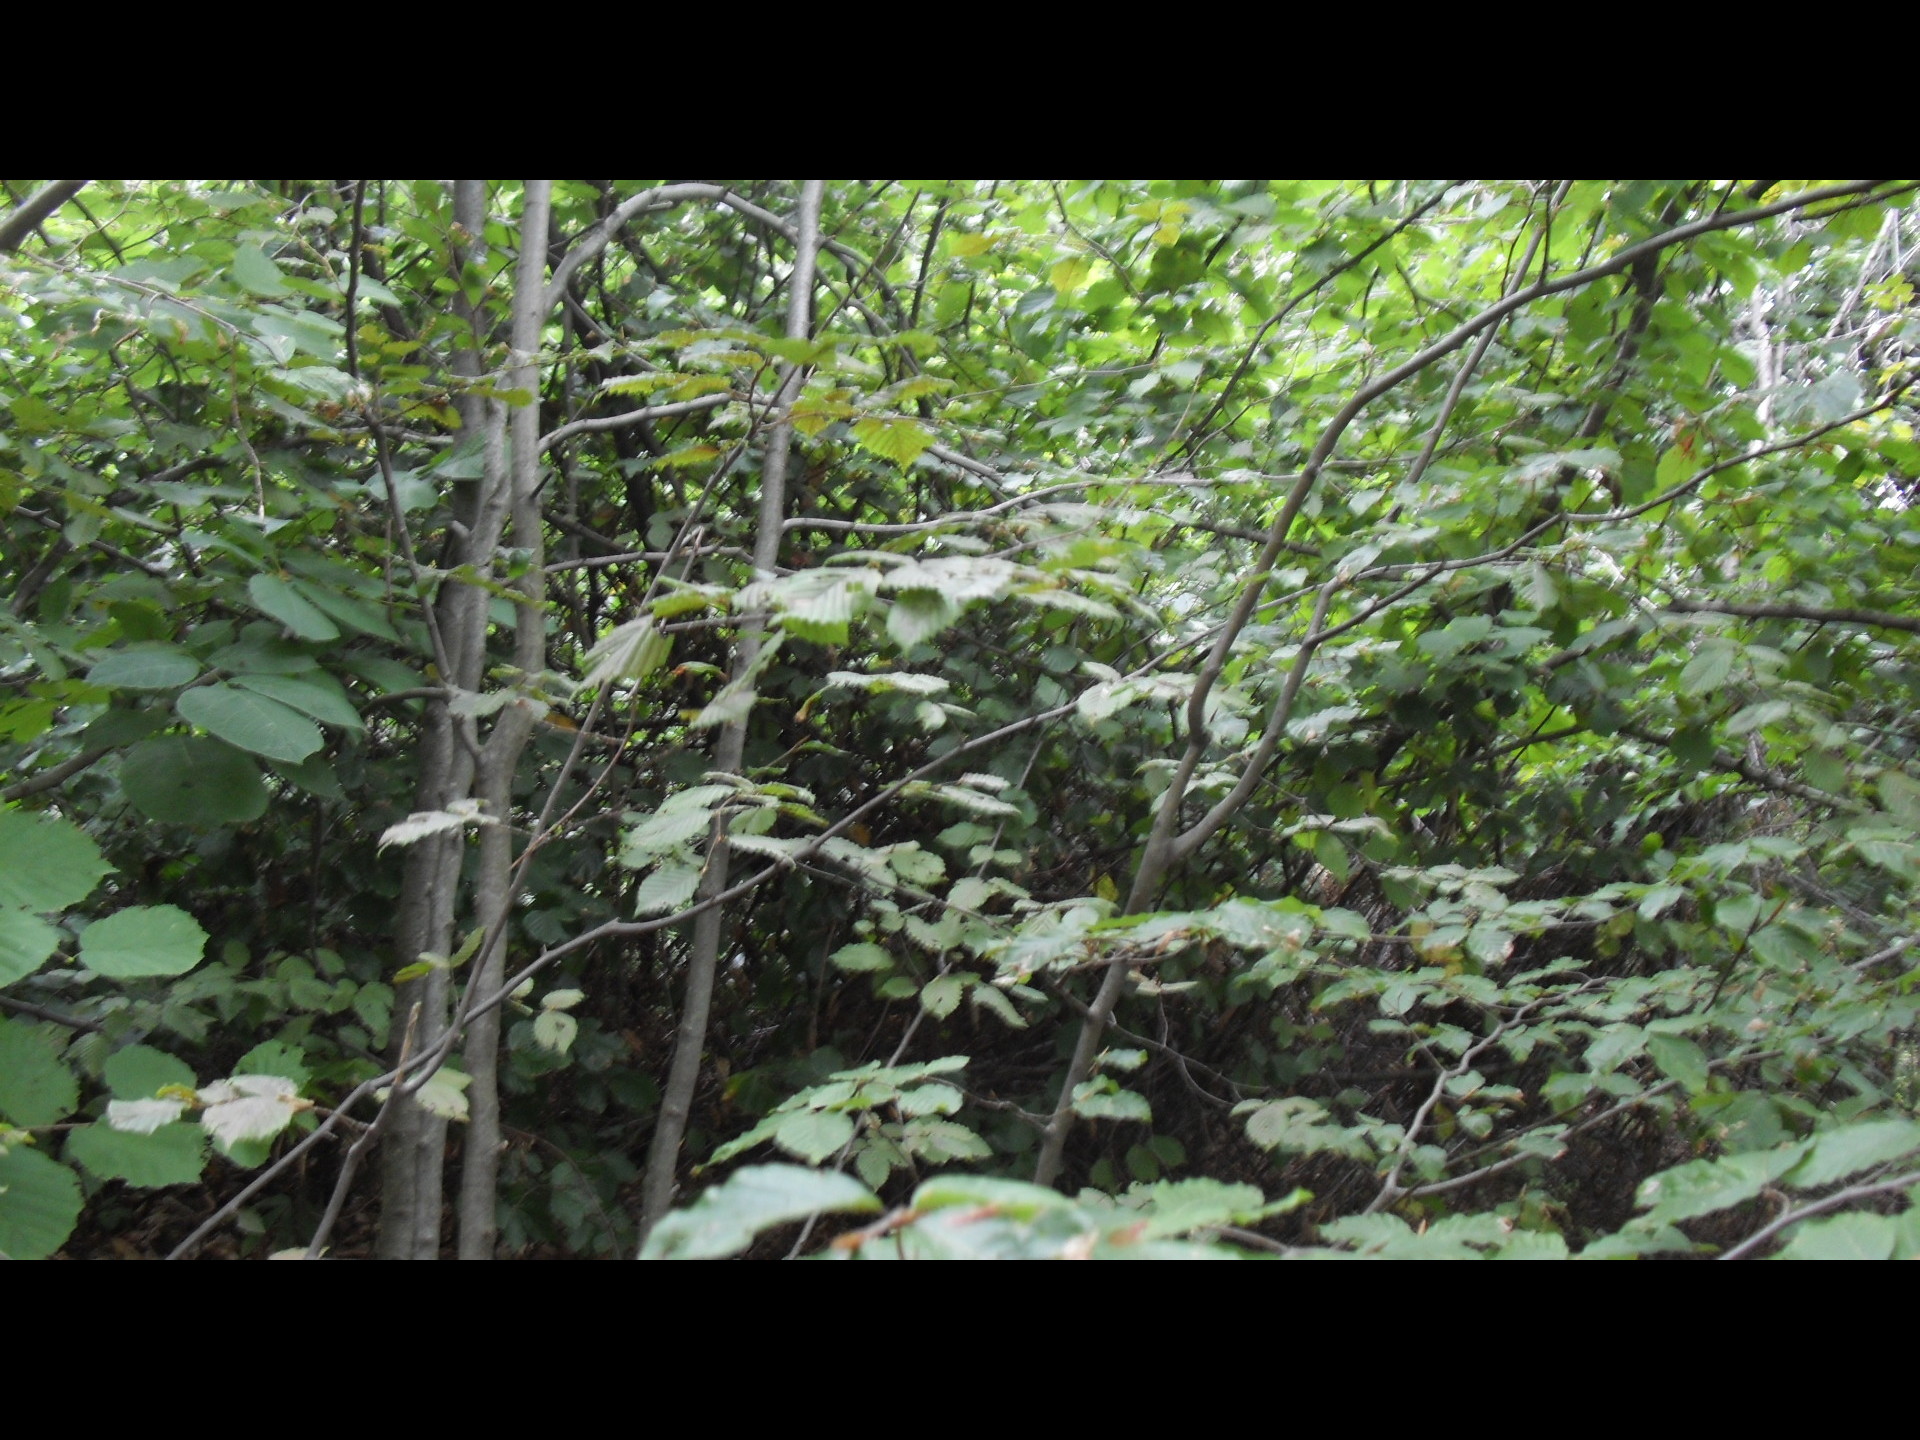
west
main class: Woodland
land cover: Broadleaved woodland
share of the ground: > 75 %
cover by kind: broadleaved forest trees 100 %
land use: Forestry
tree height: < 5 m
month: October
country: BG
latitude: 43.3678
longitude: 22.8308
